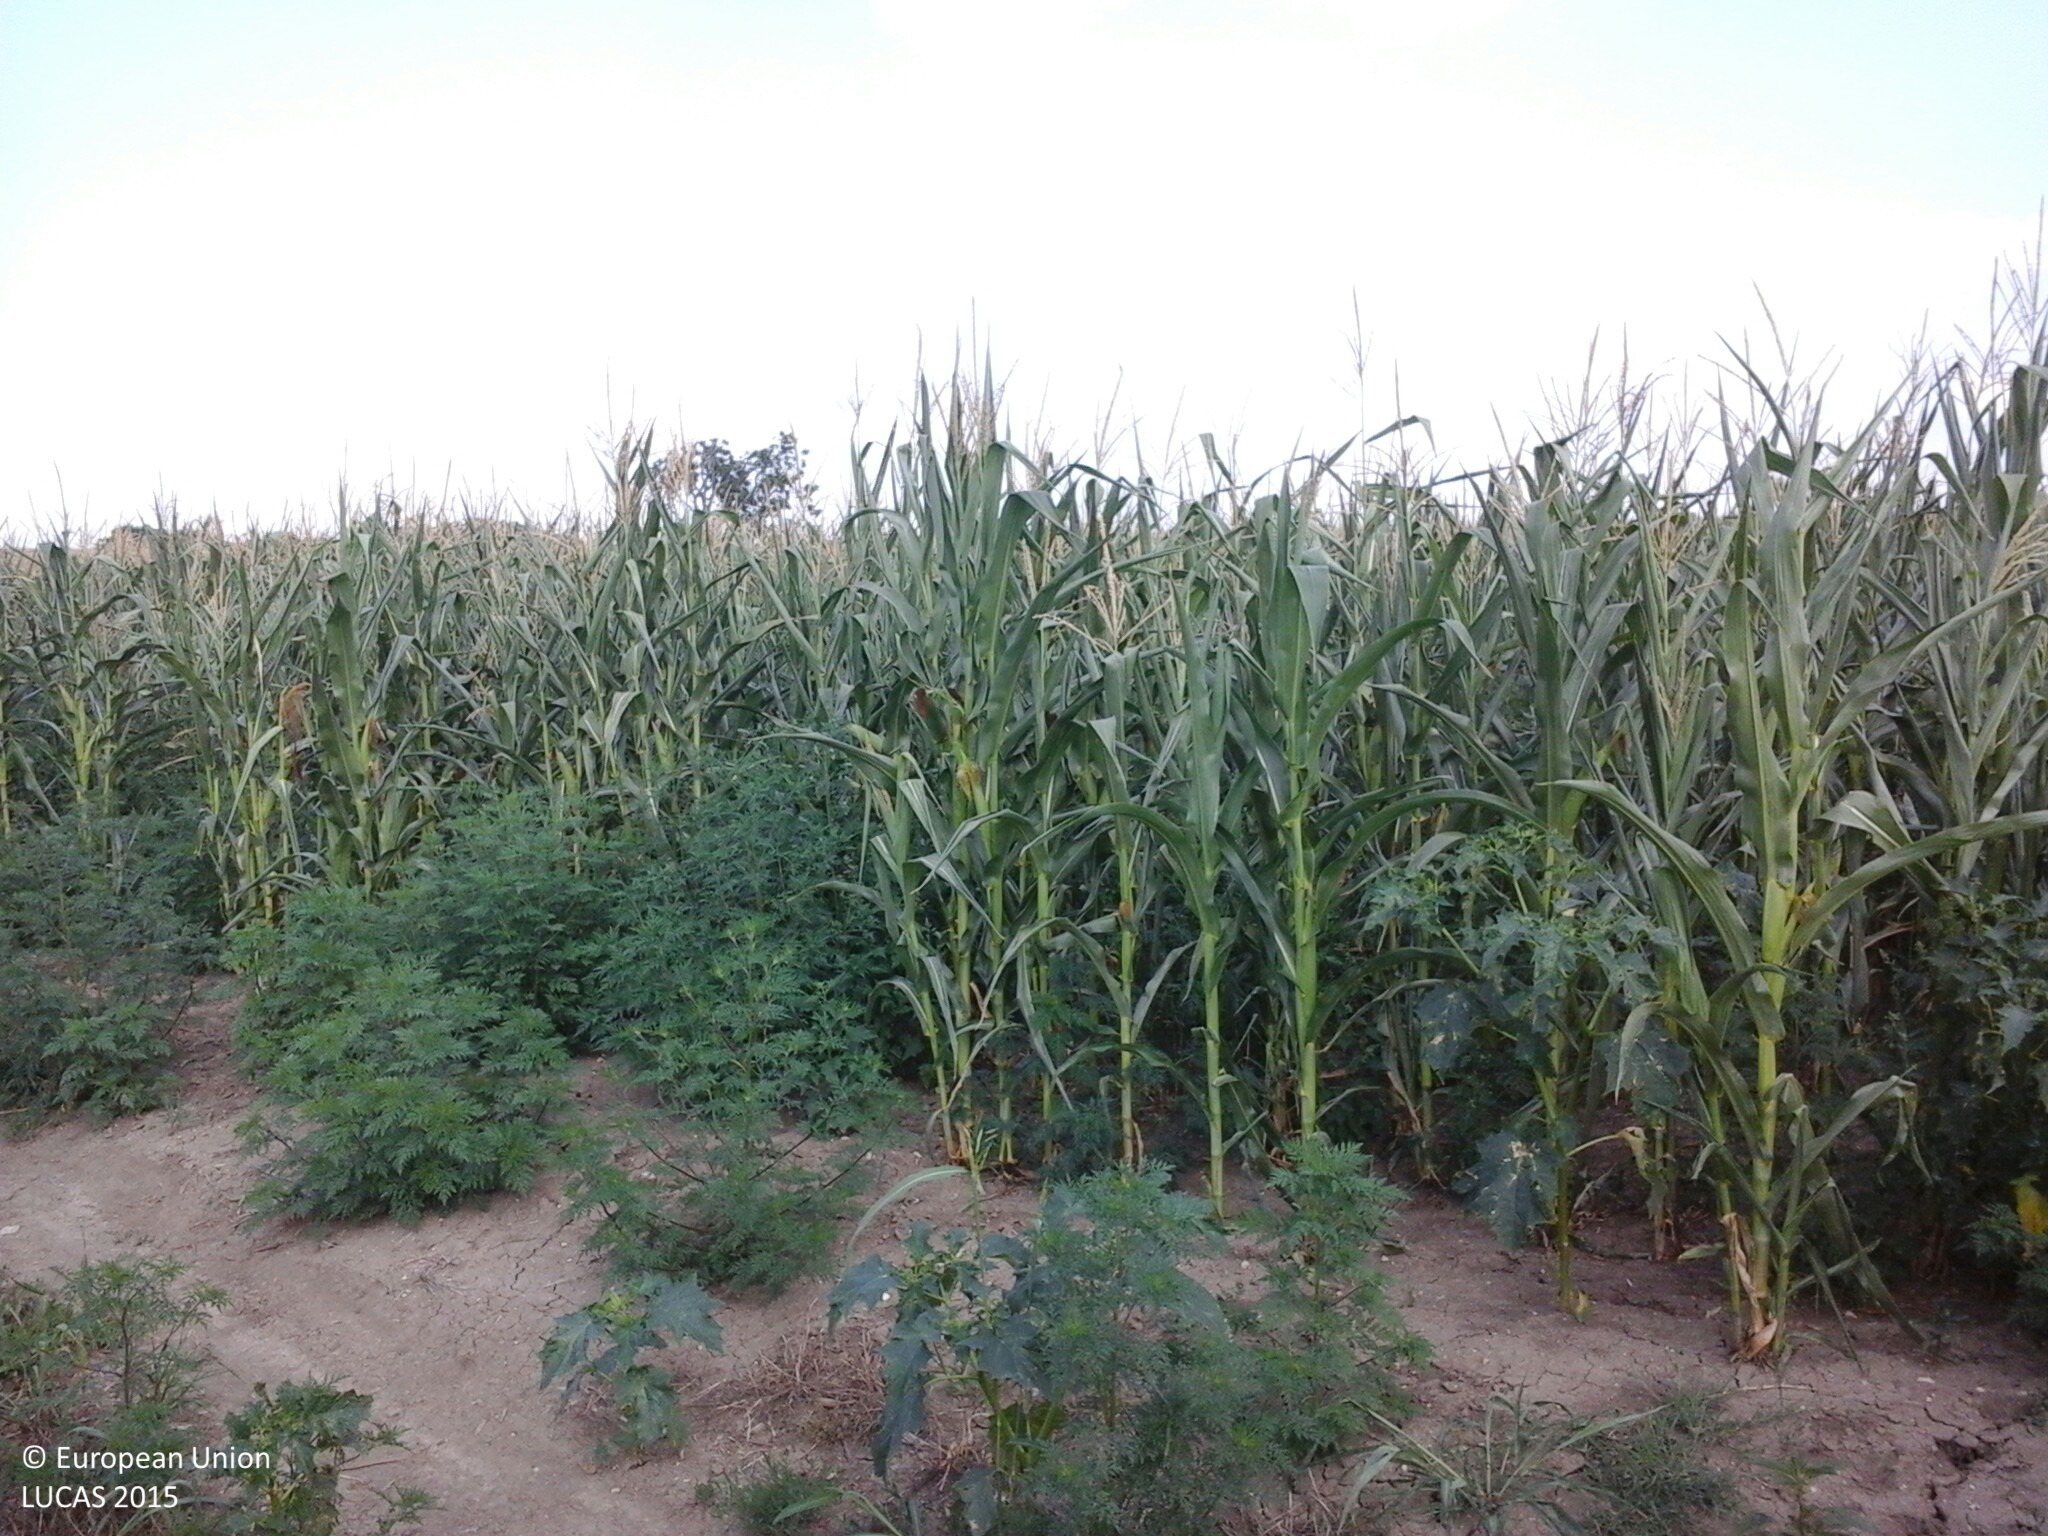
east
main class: Cropland
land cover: Sunflower
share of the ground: > 75 %
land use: Agriculture (excluding fallow land and kitchen gardens)
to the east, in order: Sunflower; Tracks; Shrubland with sparse tree cover; Maize; Shrubland with sparse tree cover; Common wheat
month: August
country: HU
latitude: 47.0903
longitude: 18.1381
